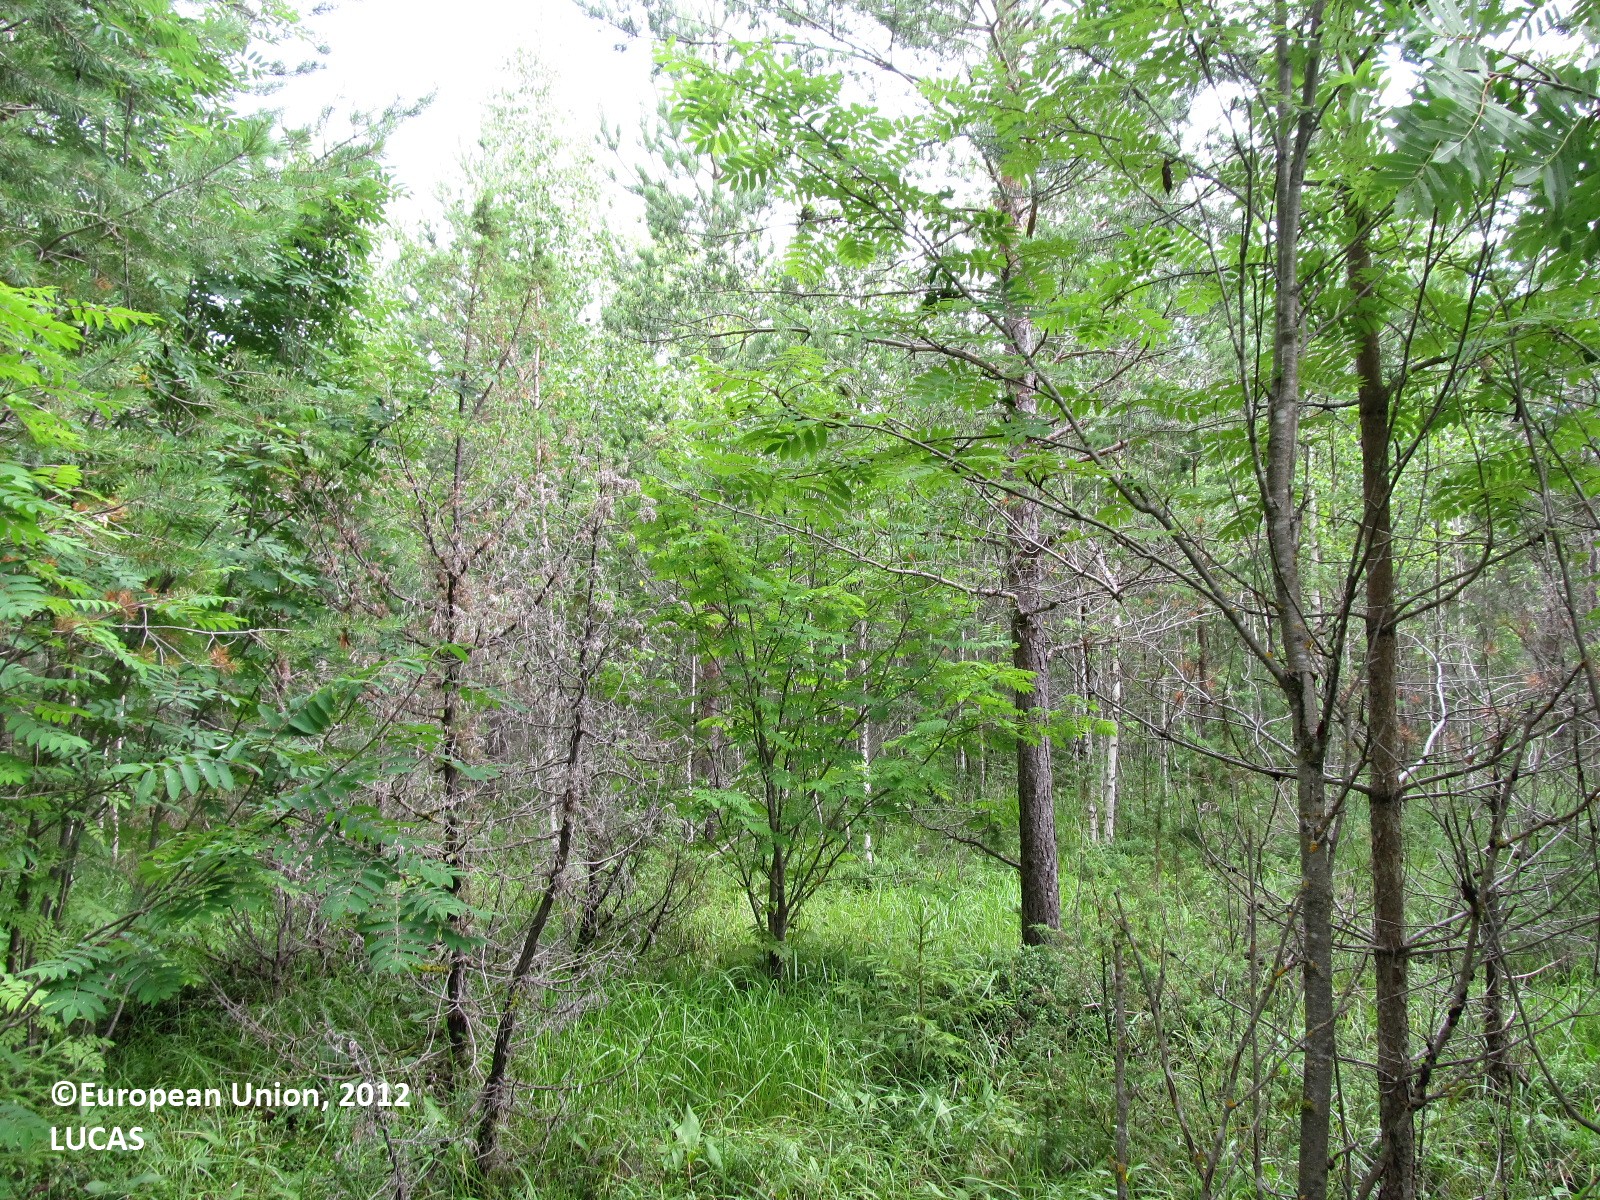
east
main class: Woodland
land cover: Pine dominated coniferous woodland
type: boreal forest
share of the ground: 25 - 50 %
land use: Forestry
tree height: > 5 m
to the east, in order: Pine dominated coniferous woodland; Broadleaved woodland; Spruce dominated mixed woodland
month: July
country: FI
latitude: 61.9382
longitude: 29.0349
